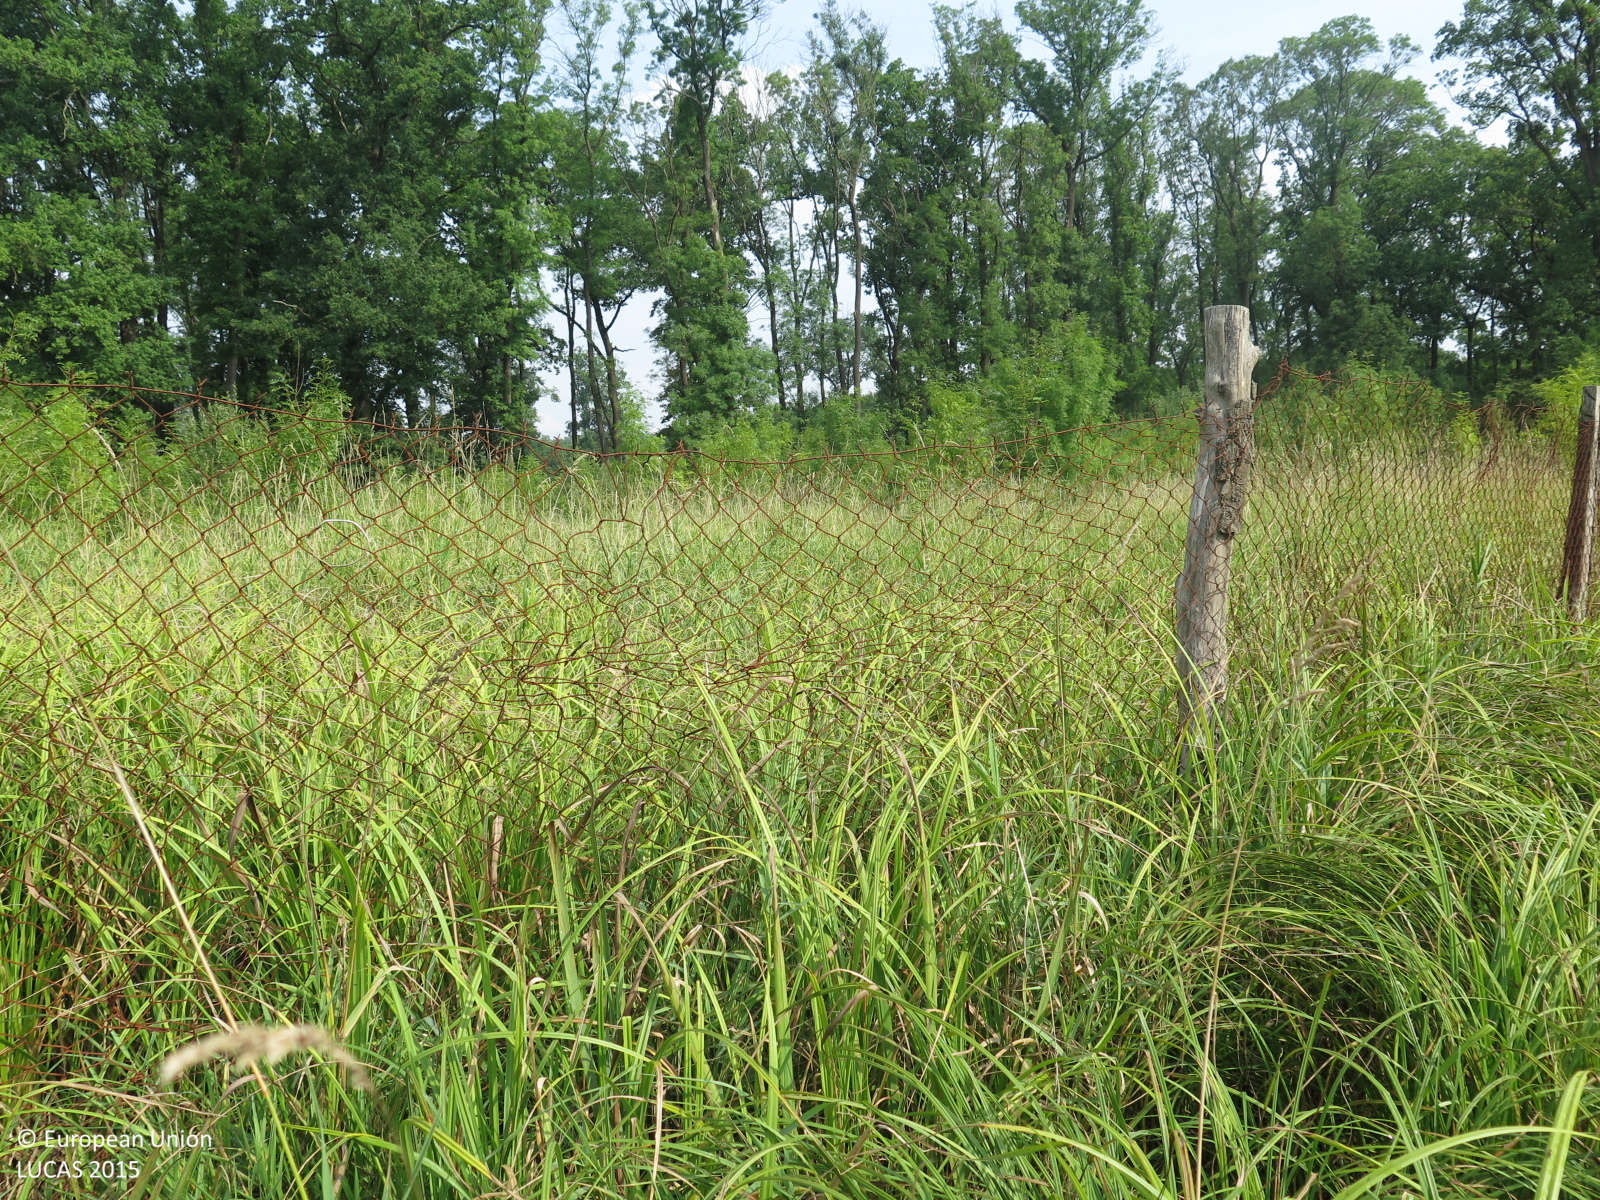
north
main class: Grassland
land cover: Grassland with sparse tree/shrub cover
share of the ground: > 75 %
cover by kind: herbaceous plants 85 %, shrubs 10 %, coniferous forest trees 5 %
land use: Forestry
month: August
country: CZ
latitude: 48.7065
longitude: 16.9796
